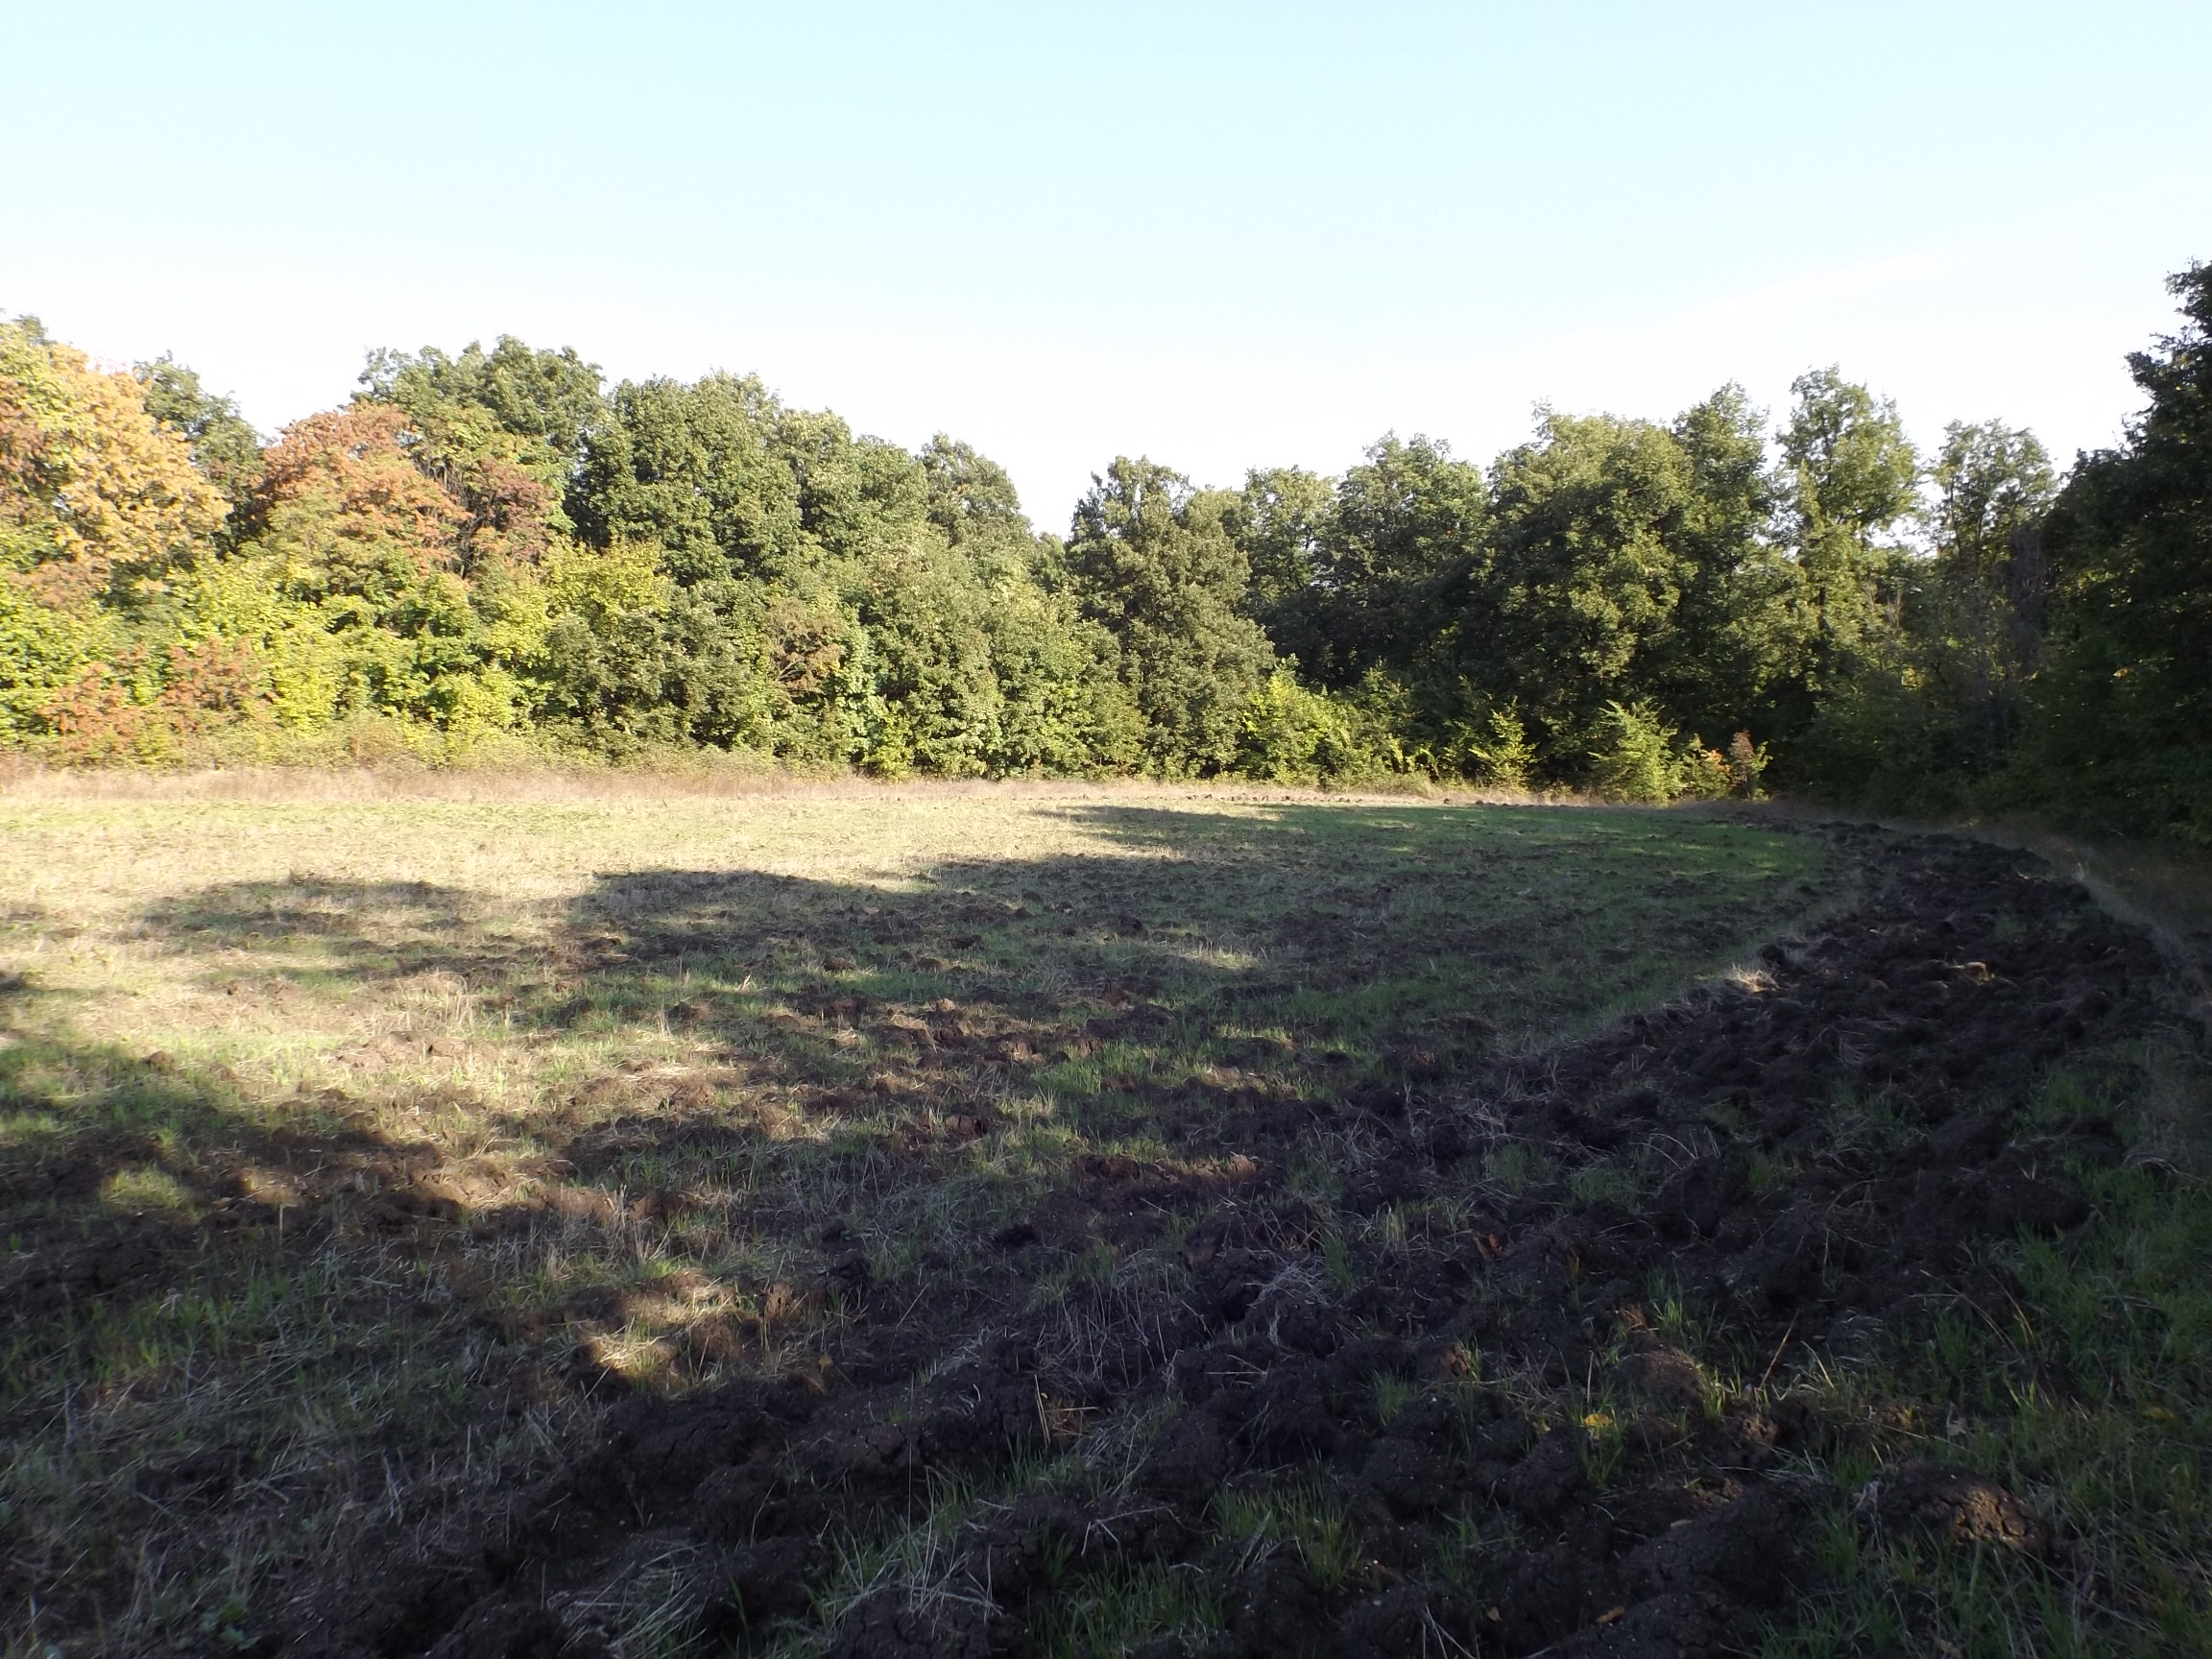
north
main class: Cropland
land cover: Barley
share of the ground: < 10 %
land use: Agriculture (excluding fallow land and kitchen gardens)
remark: Harvested field
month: October
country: BG
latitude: 42.9191
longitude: 27.8352
